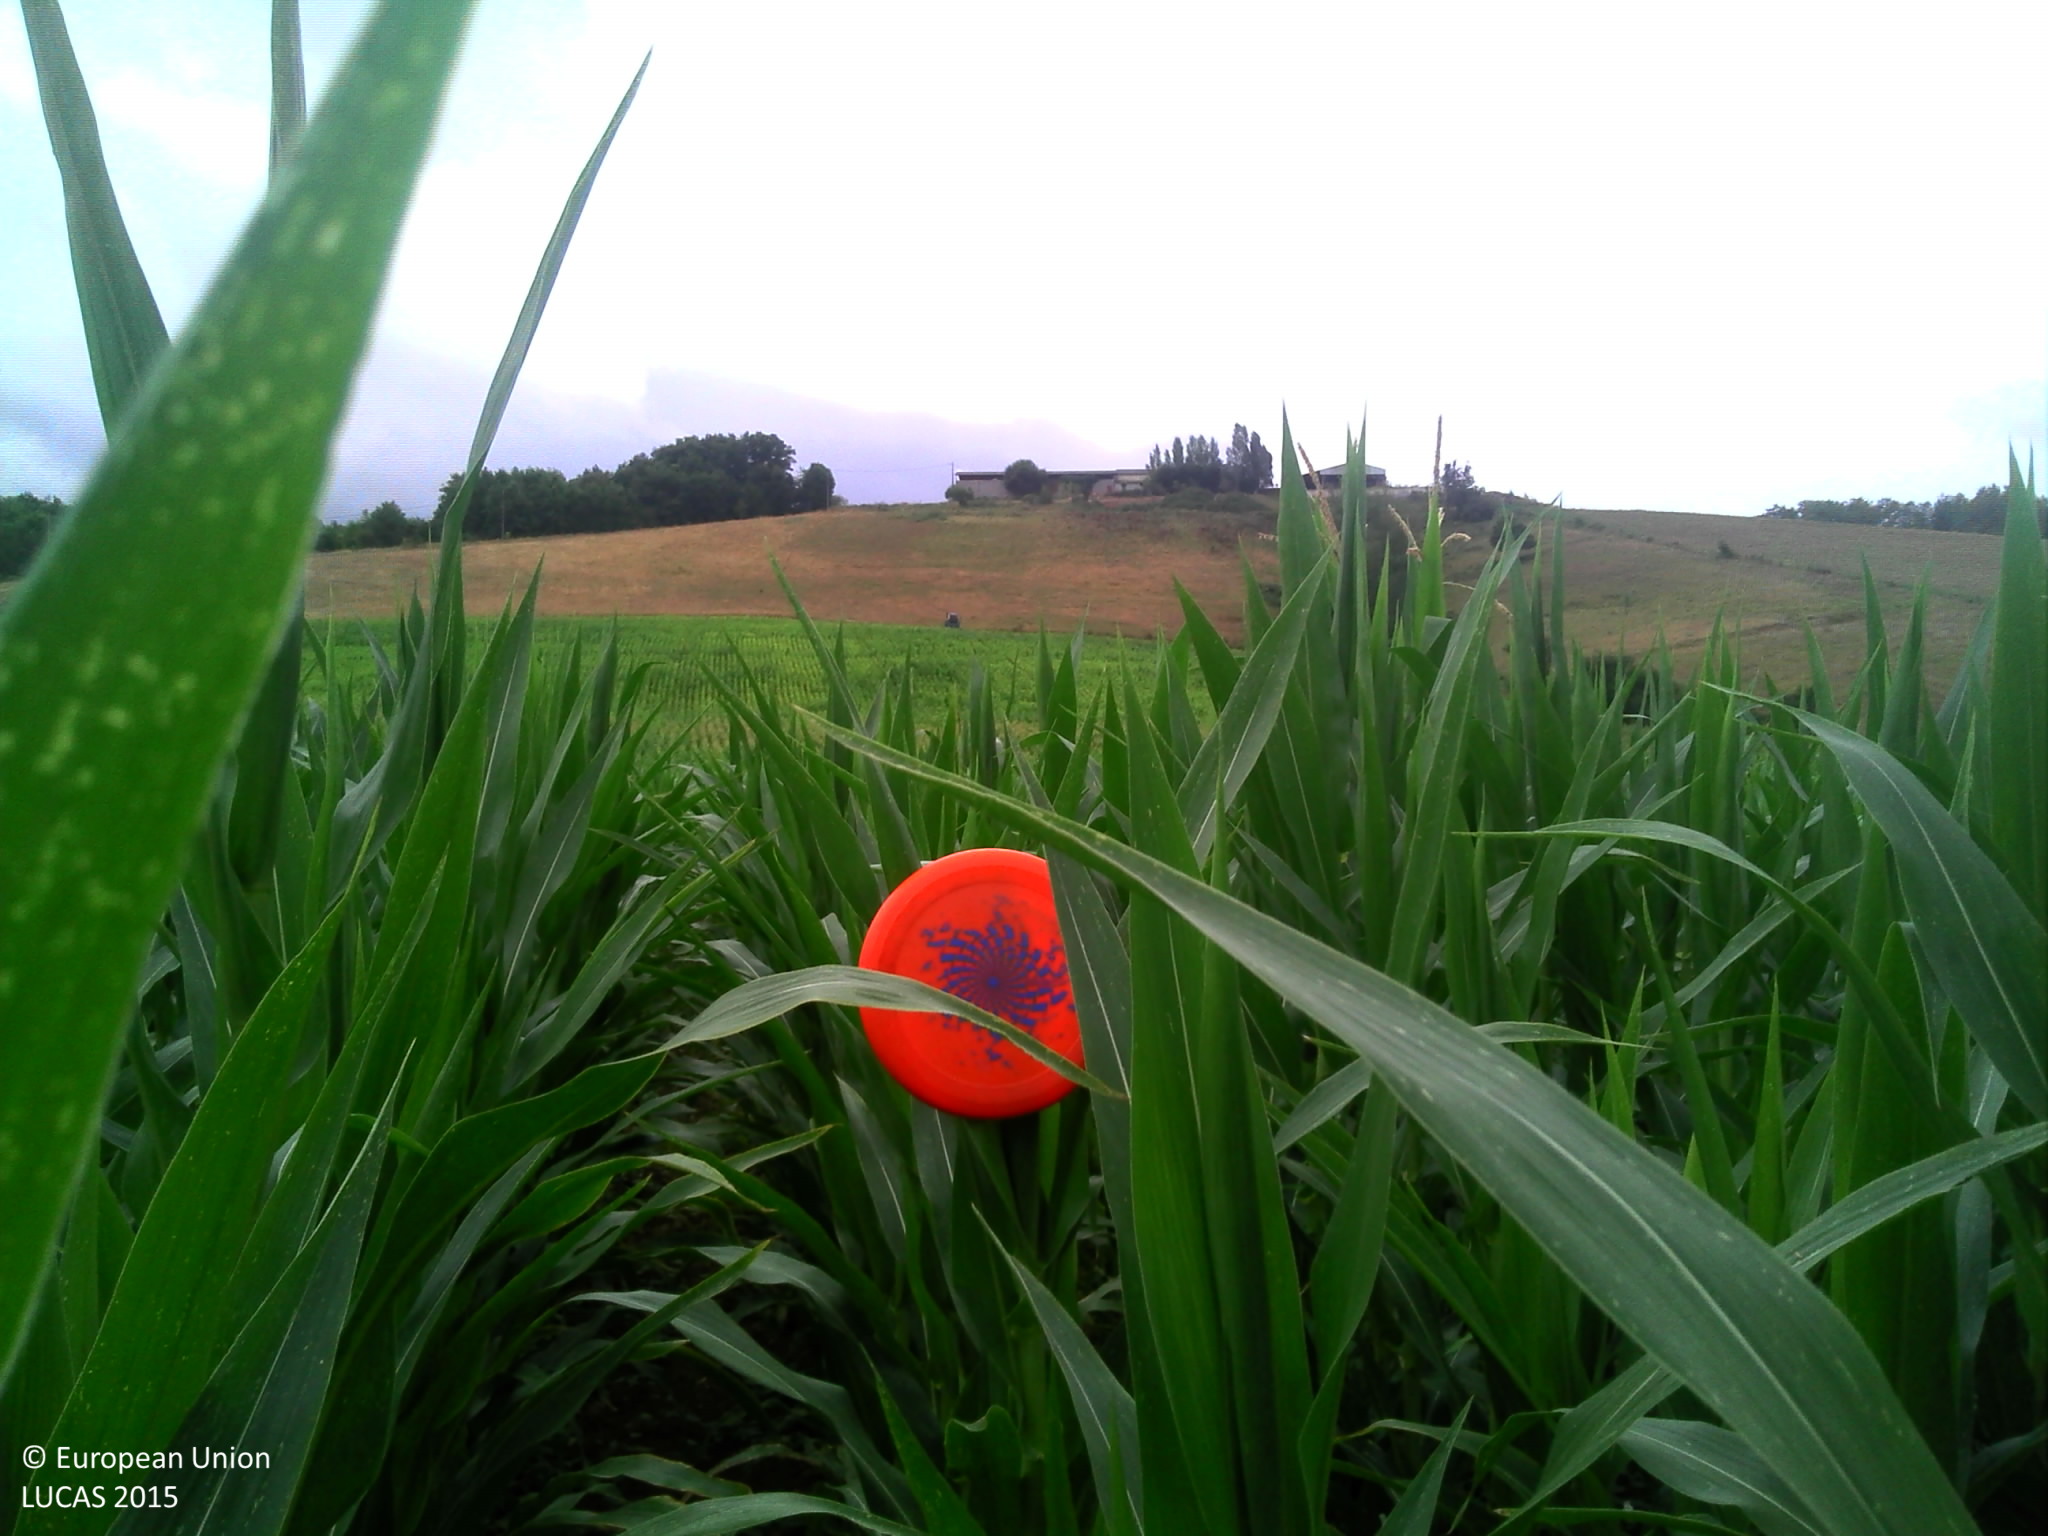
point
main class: Cropland
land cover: Maize
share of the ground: > 75 %
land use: Agriculture (excluding fallow land and kitchen gardens)
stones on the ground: < 10 %
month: July
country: FR
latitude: 43.2559
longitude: 0.8494
